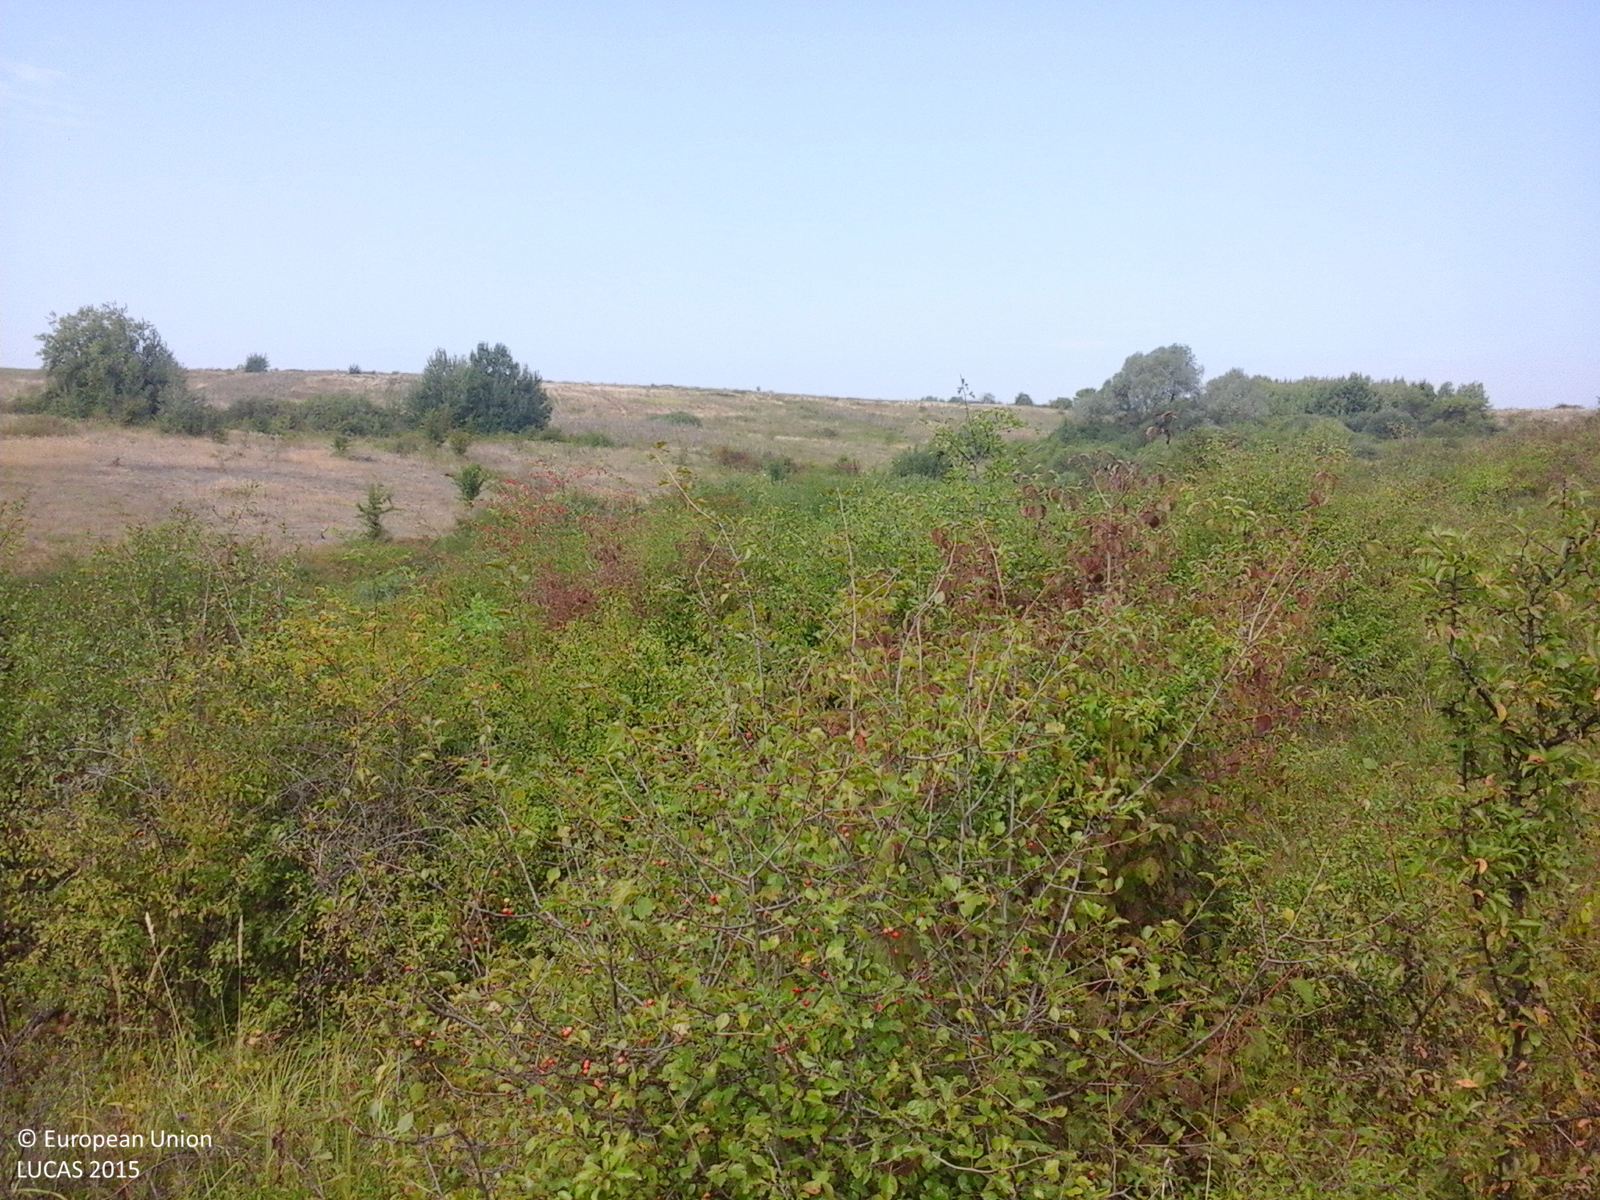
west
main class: Shrubland
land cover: Shrubland with sparse tree cover
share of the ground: > 75 %
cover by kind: shrubs 95 %, broadleaved forest trees 5 %
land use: Forestry
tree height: < 5 m
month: August
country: RO
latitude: 46.3394
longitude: 22.2201
